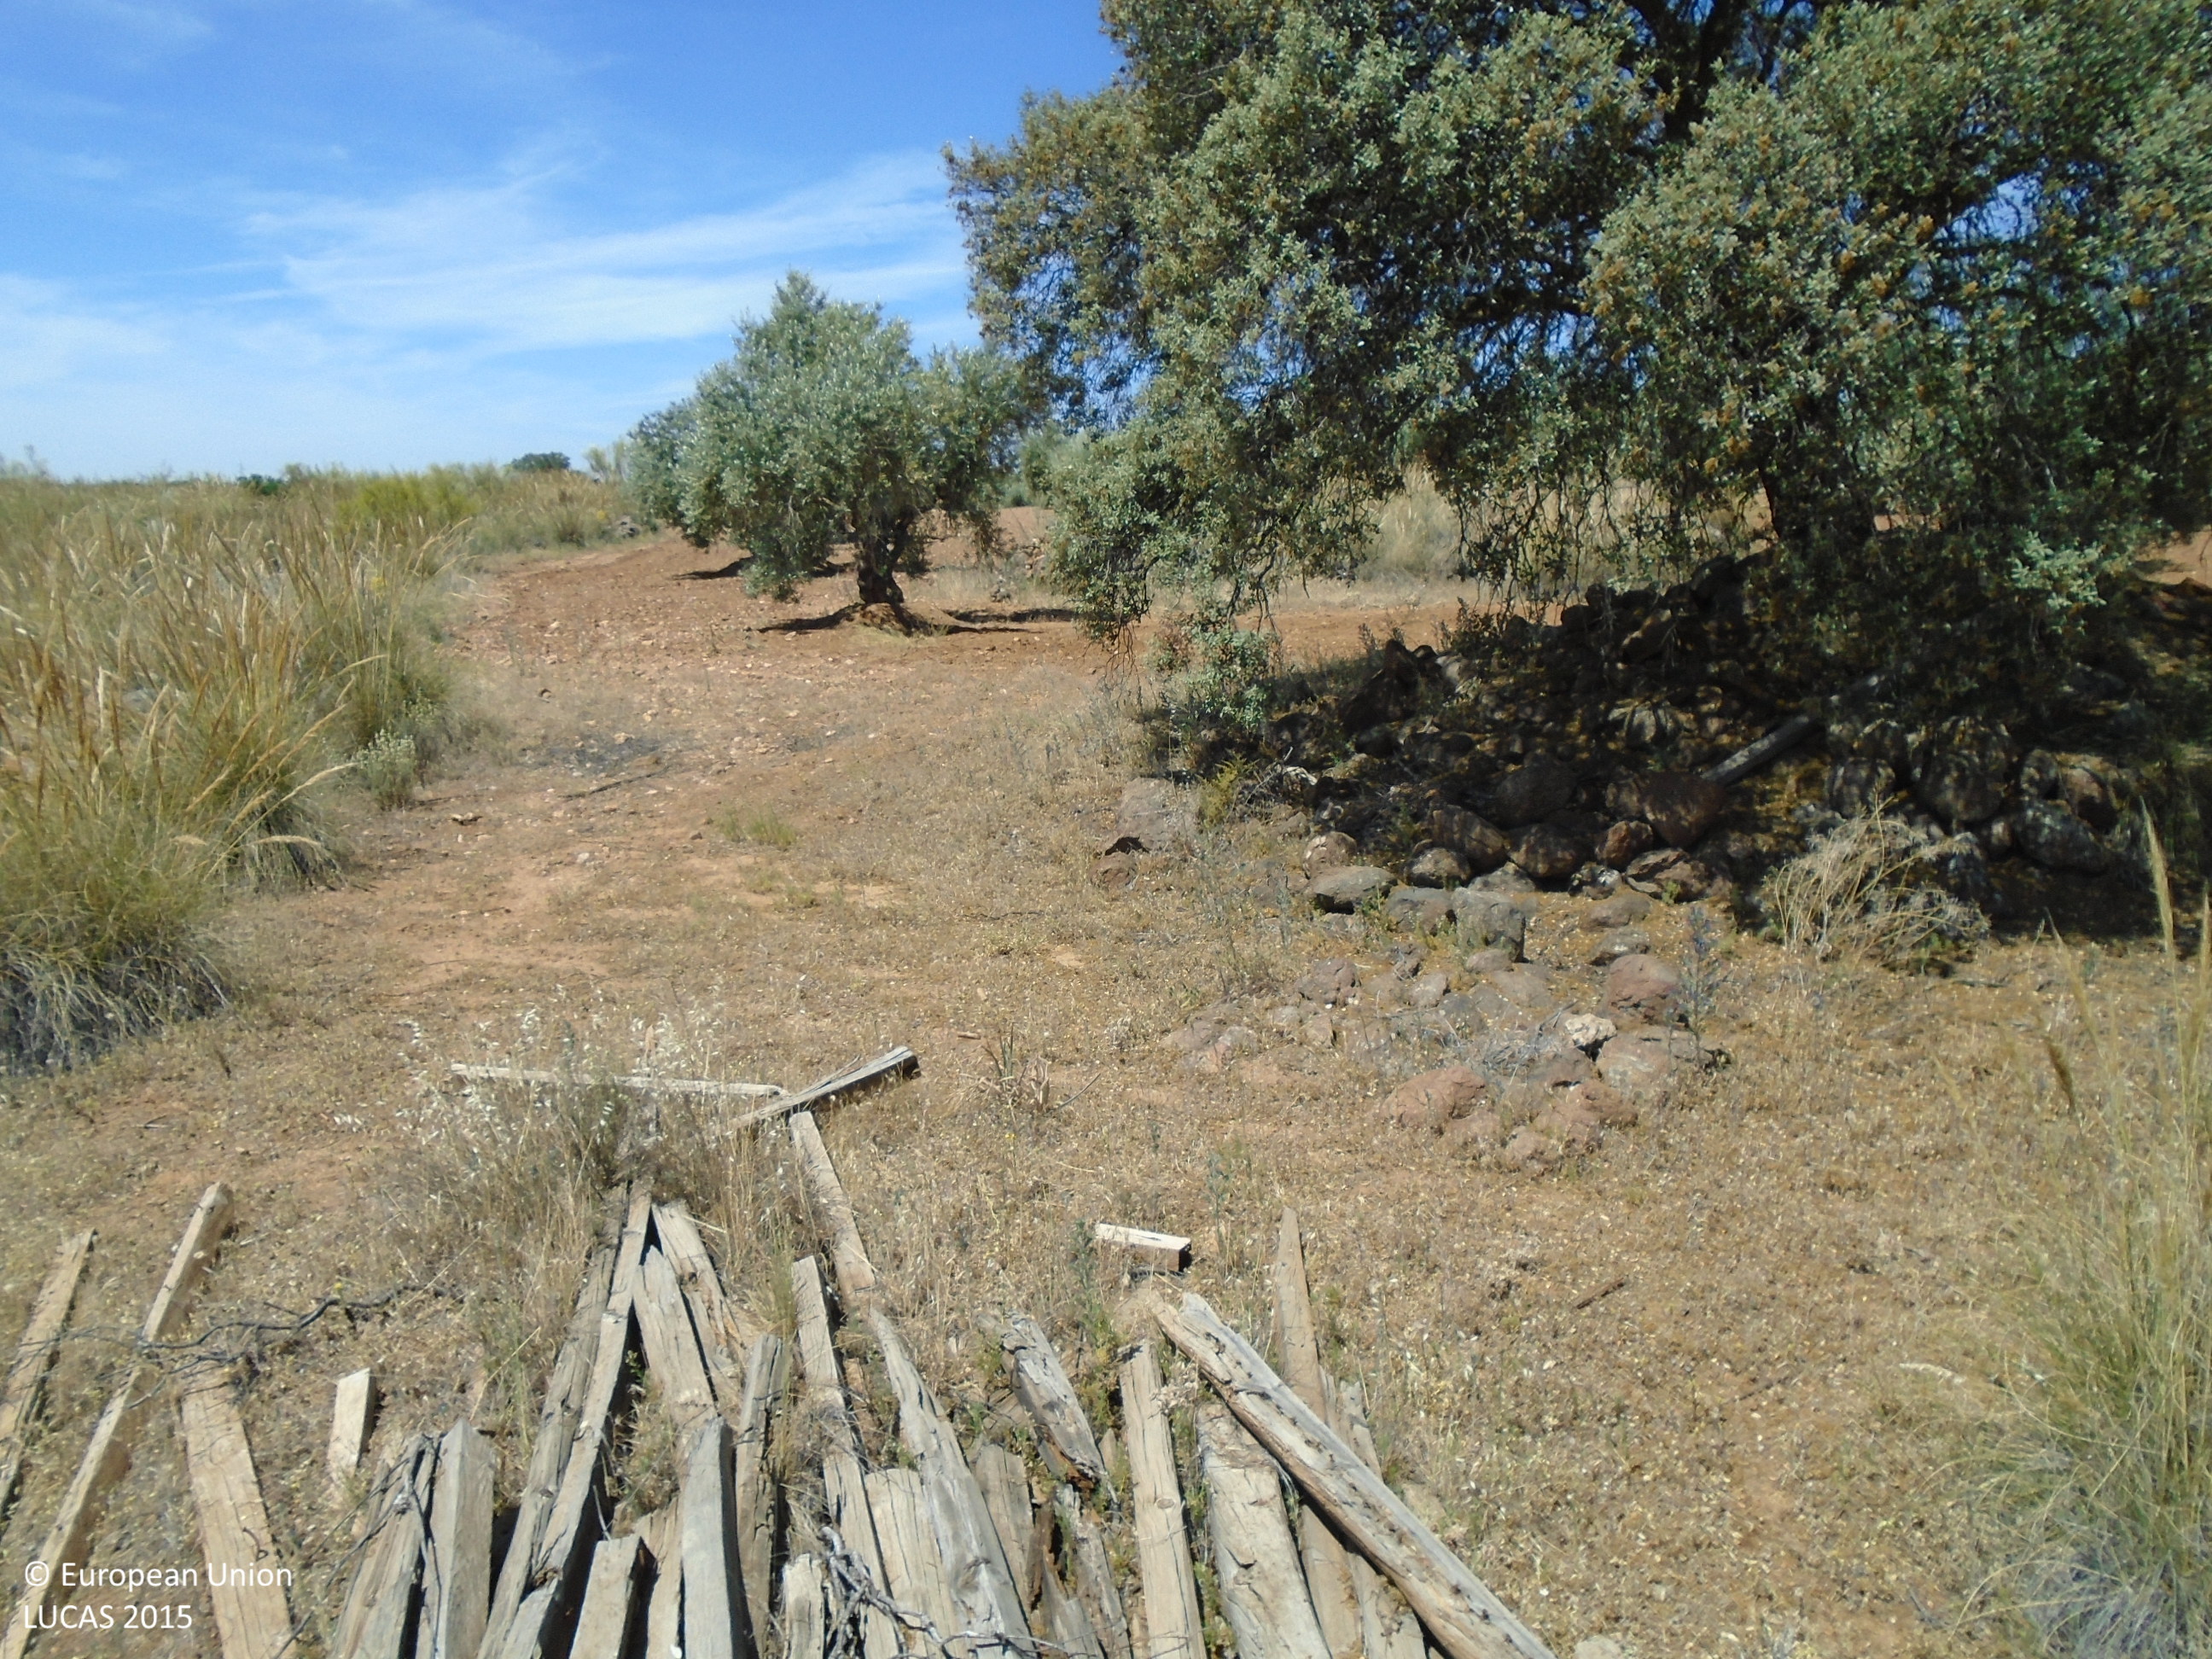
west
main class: Shrubland
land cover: Shrubland without tree cover
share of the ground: > 75 %
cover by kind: herbaceous plants 50 %, shrubs 40 %, consolidated bare surface 10 %
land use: Semi-natural and natural areas not in use
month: May
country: ES
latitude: 39.8033
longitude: -3.7775
